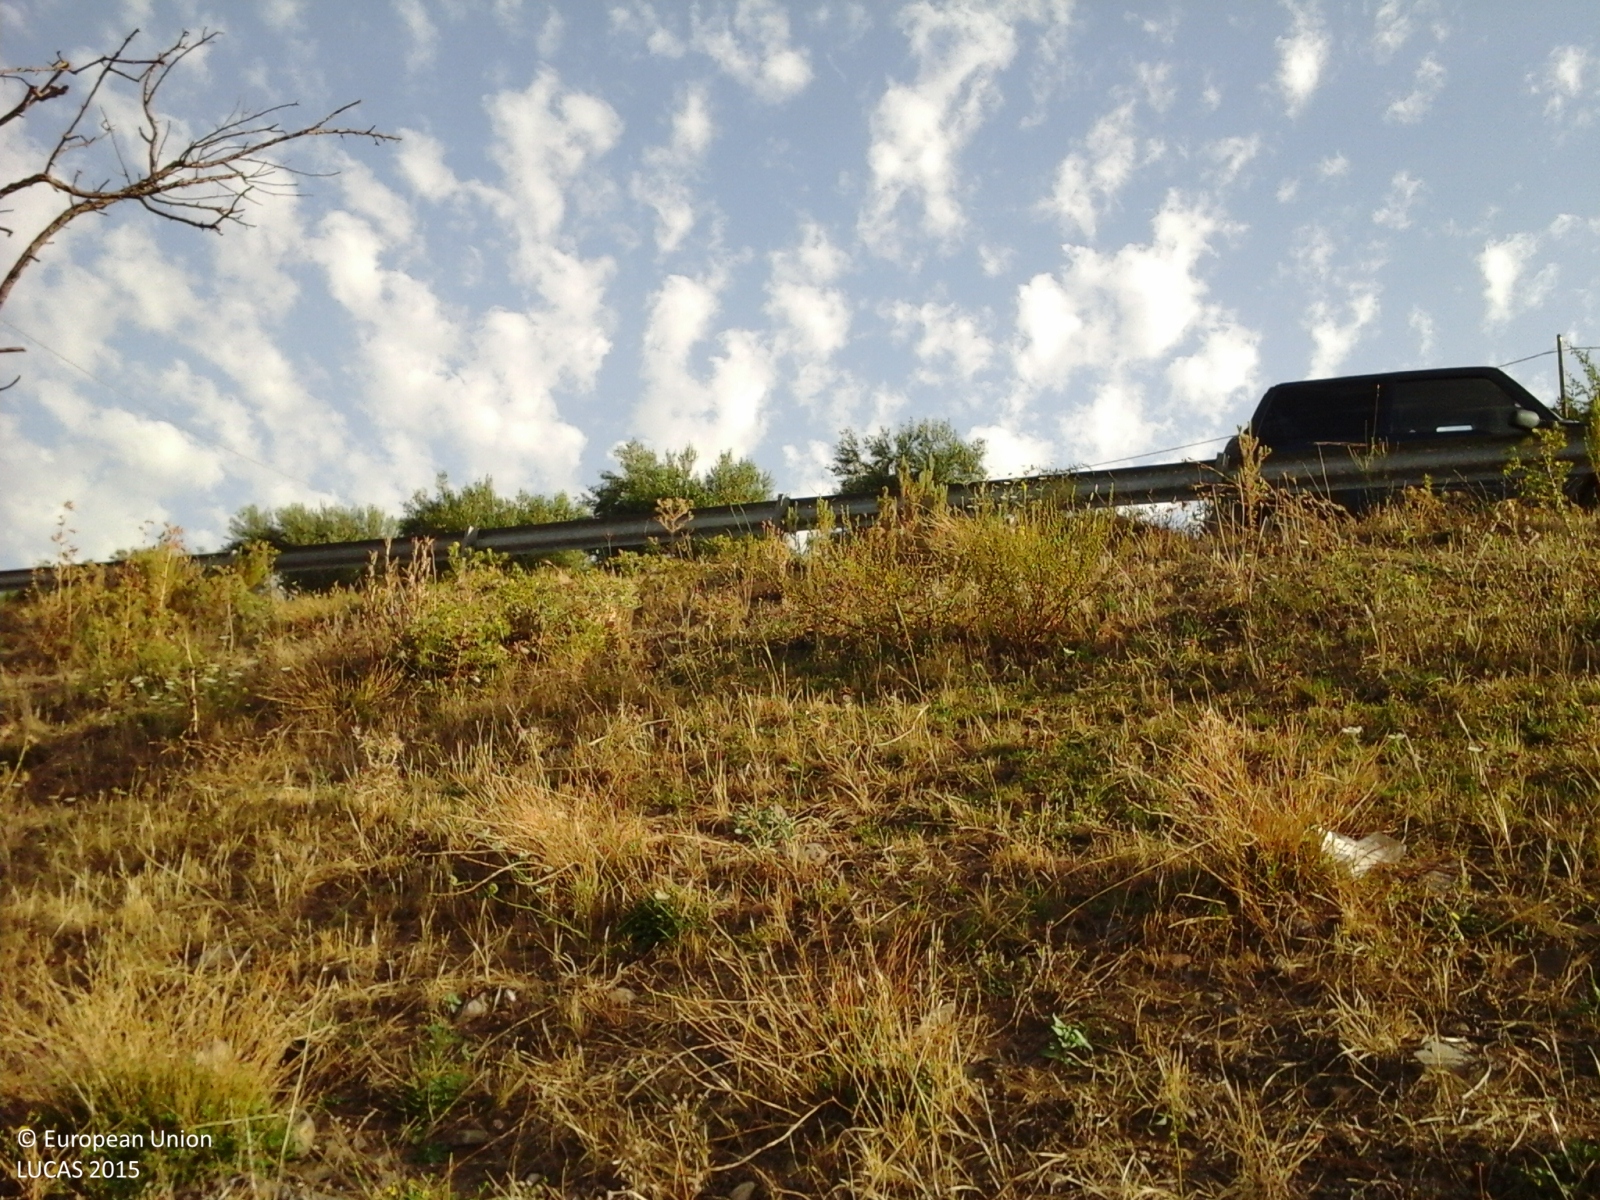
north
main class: Grassland
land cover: Spontaneously vegetated surfaces
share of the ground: 10 - 25 %
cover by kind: unconsolidated bare surface 75 %, herbaceous plants 25 %
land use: Agriculture (excluding fallow land and kitchen gardens)
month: August
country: IT
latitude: 37.1538
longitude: 14.7937
